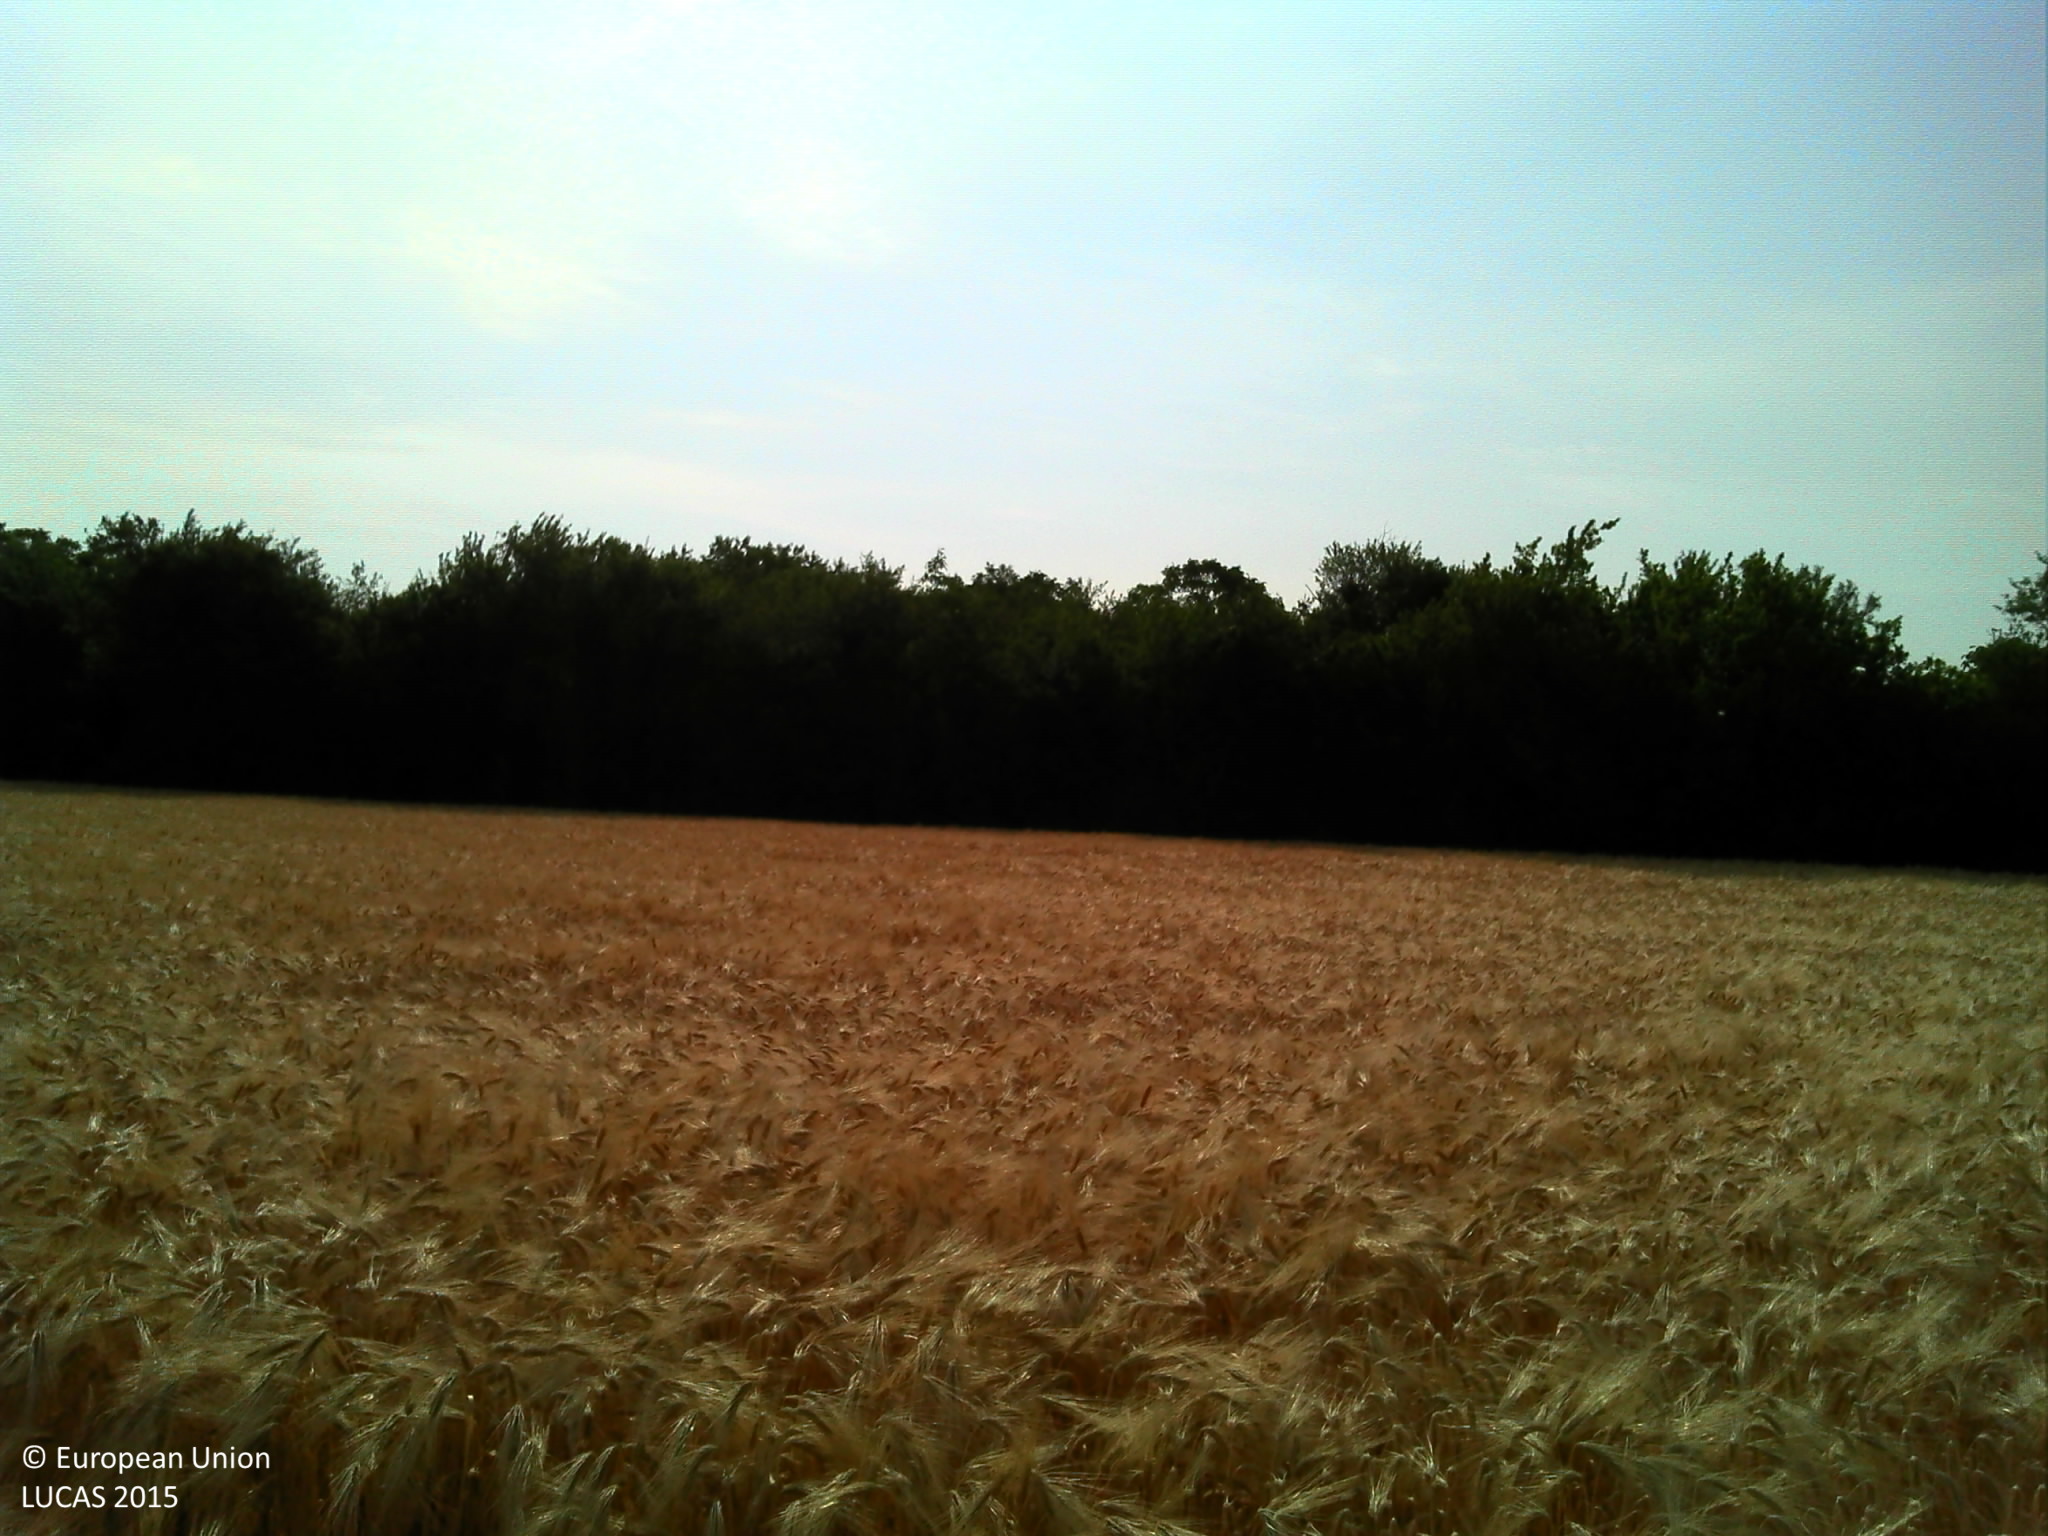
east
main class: Cropland
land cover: Barley
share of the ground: > 75 %
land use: Agriculture (excluding fallow land and kitchen gardens)
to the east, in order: Barley; Broadleaved woodland; Barley; Single bushes/trees; Barley; Grass margins
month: June
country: FR
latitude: 47.0394
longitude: 4.8549
